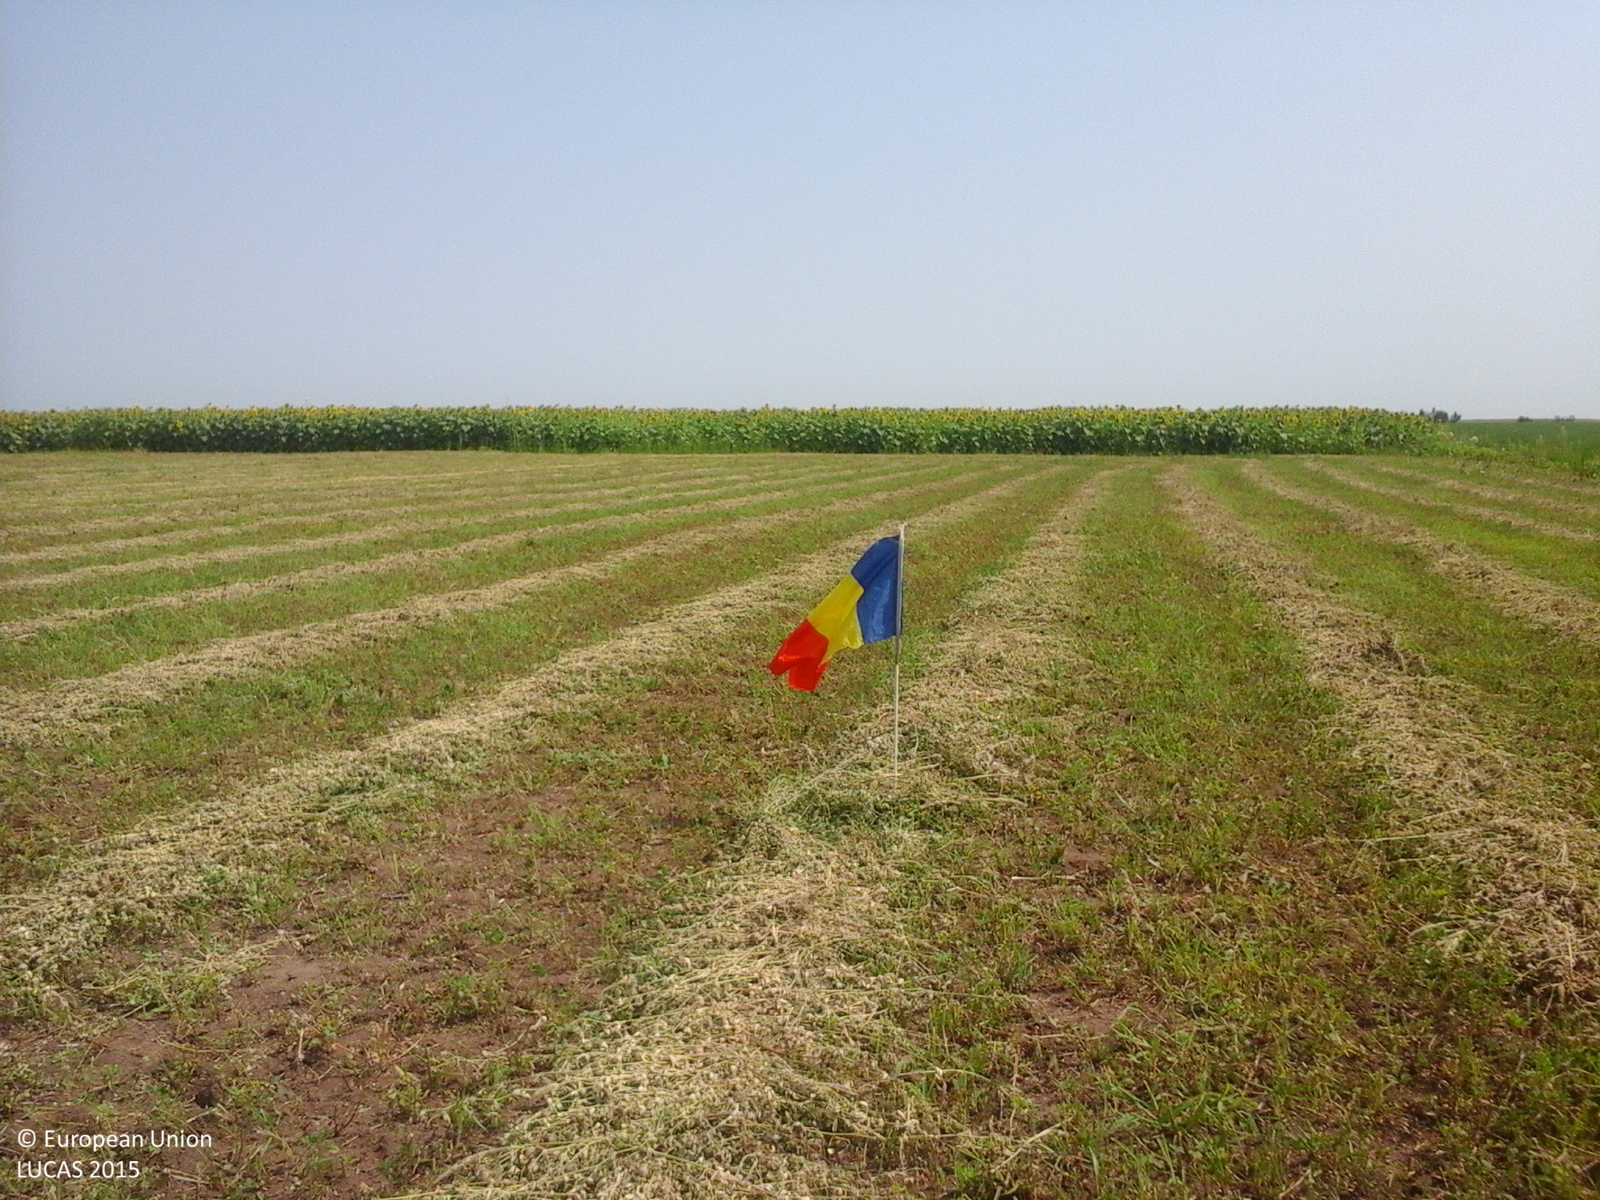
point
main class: Cropland
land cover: Lucerne
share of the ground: > 75 %
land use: Agriculture (excluding fallow land and kitchen gardens)
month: July
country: RO
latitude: 44.8163
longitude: 26.5207
